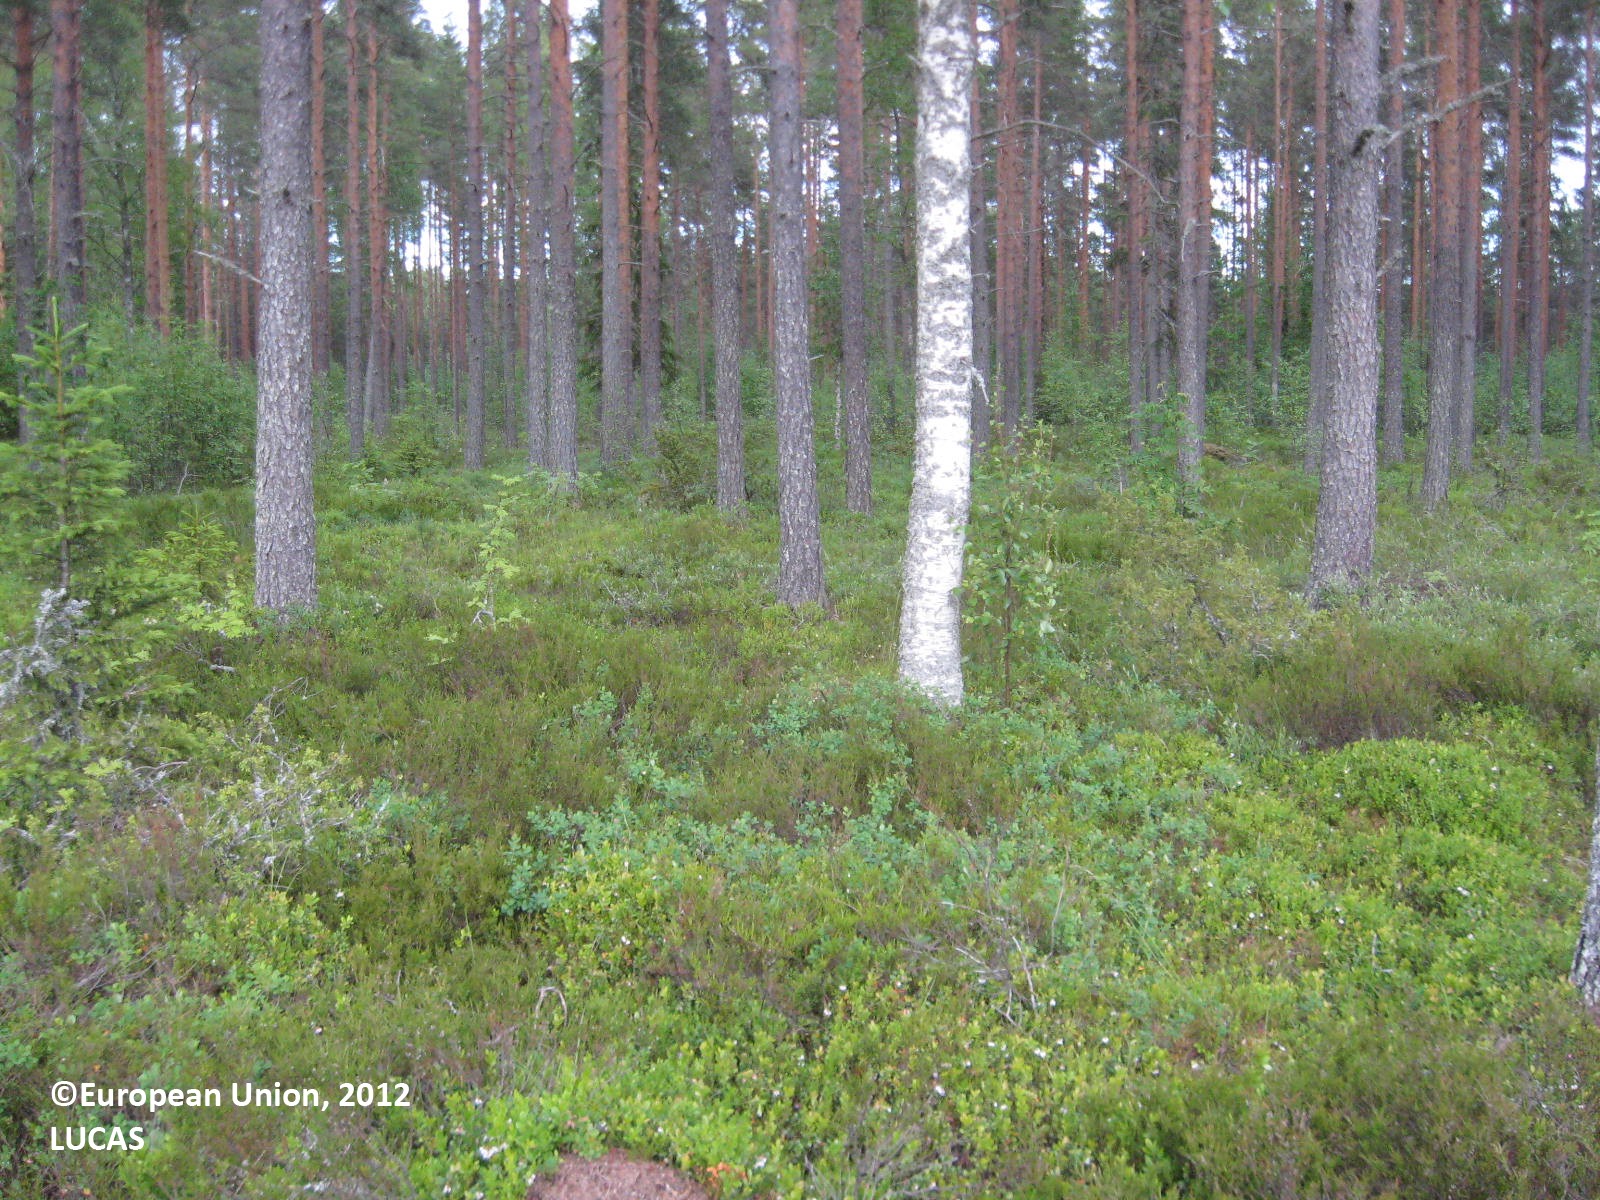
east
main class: Shrubland
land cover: Shrubland without tree cover
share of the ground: > 75 %
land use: Energy production
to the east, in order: Shrubland without tree cover; Grassland without tree/shrub cover; Pine dominated coniferous woodland; Ditches and canals; Pine dominated coniferous woodland; Ditches and canals; Pine dominated coniferous woodland
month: June
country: FI
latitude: 62.7371
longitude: 21.7262
